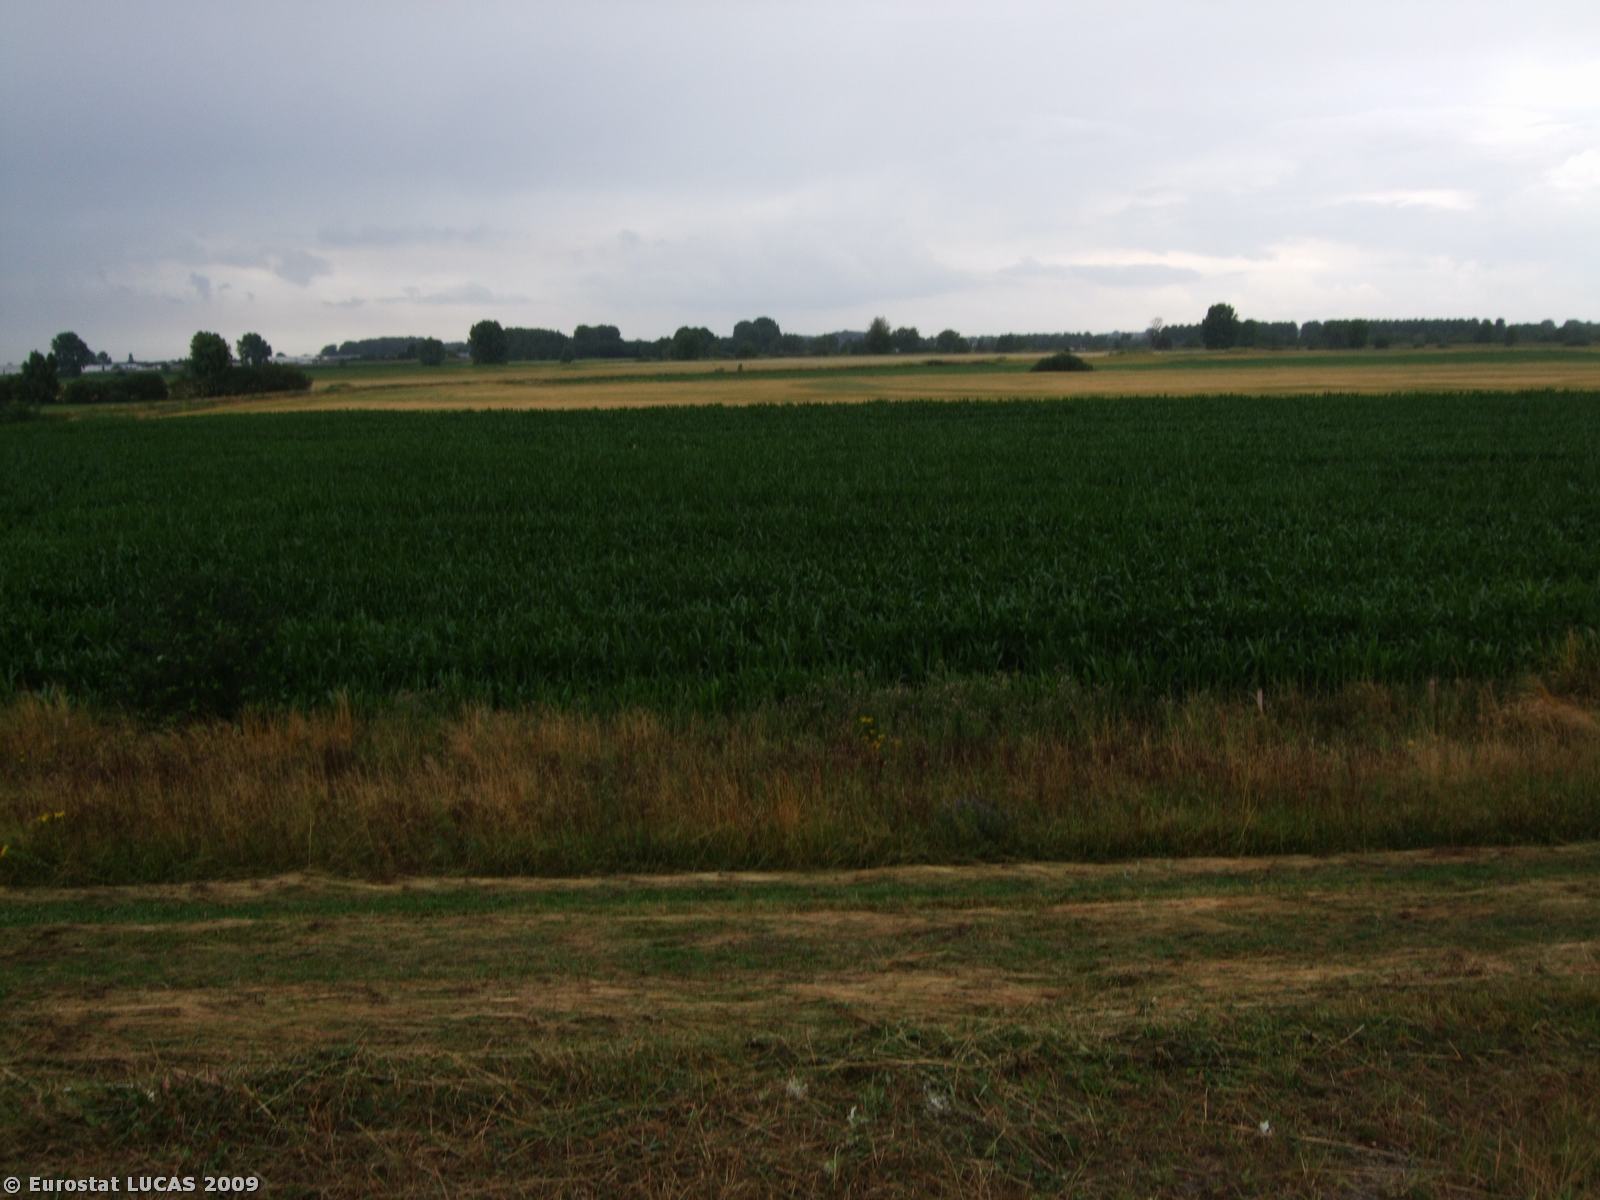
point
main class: Cropland
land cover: Maize
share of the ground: > 75 %
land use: Agriculture (excluding fallow land and kitchen gardens)
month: July
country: NL
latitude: 51.8214
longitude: 5.4281
